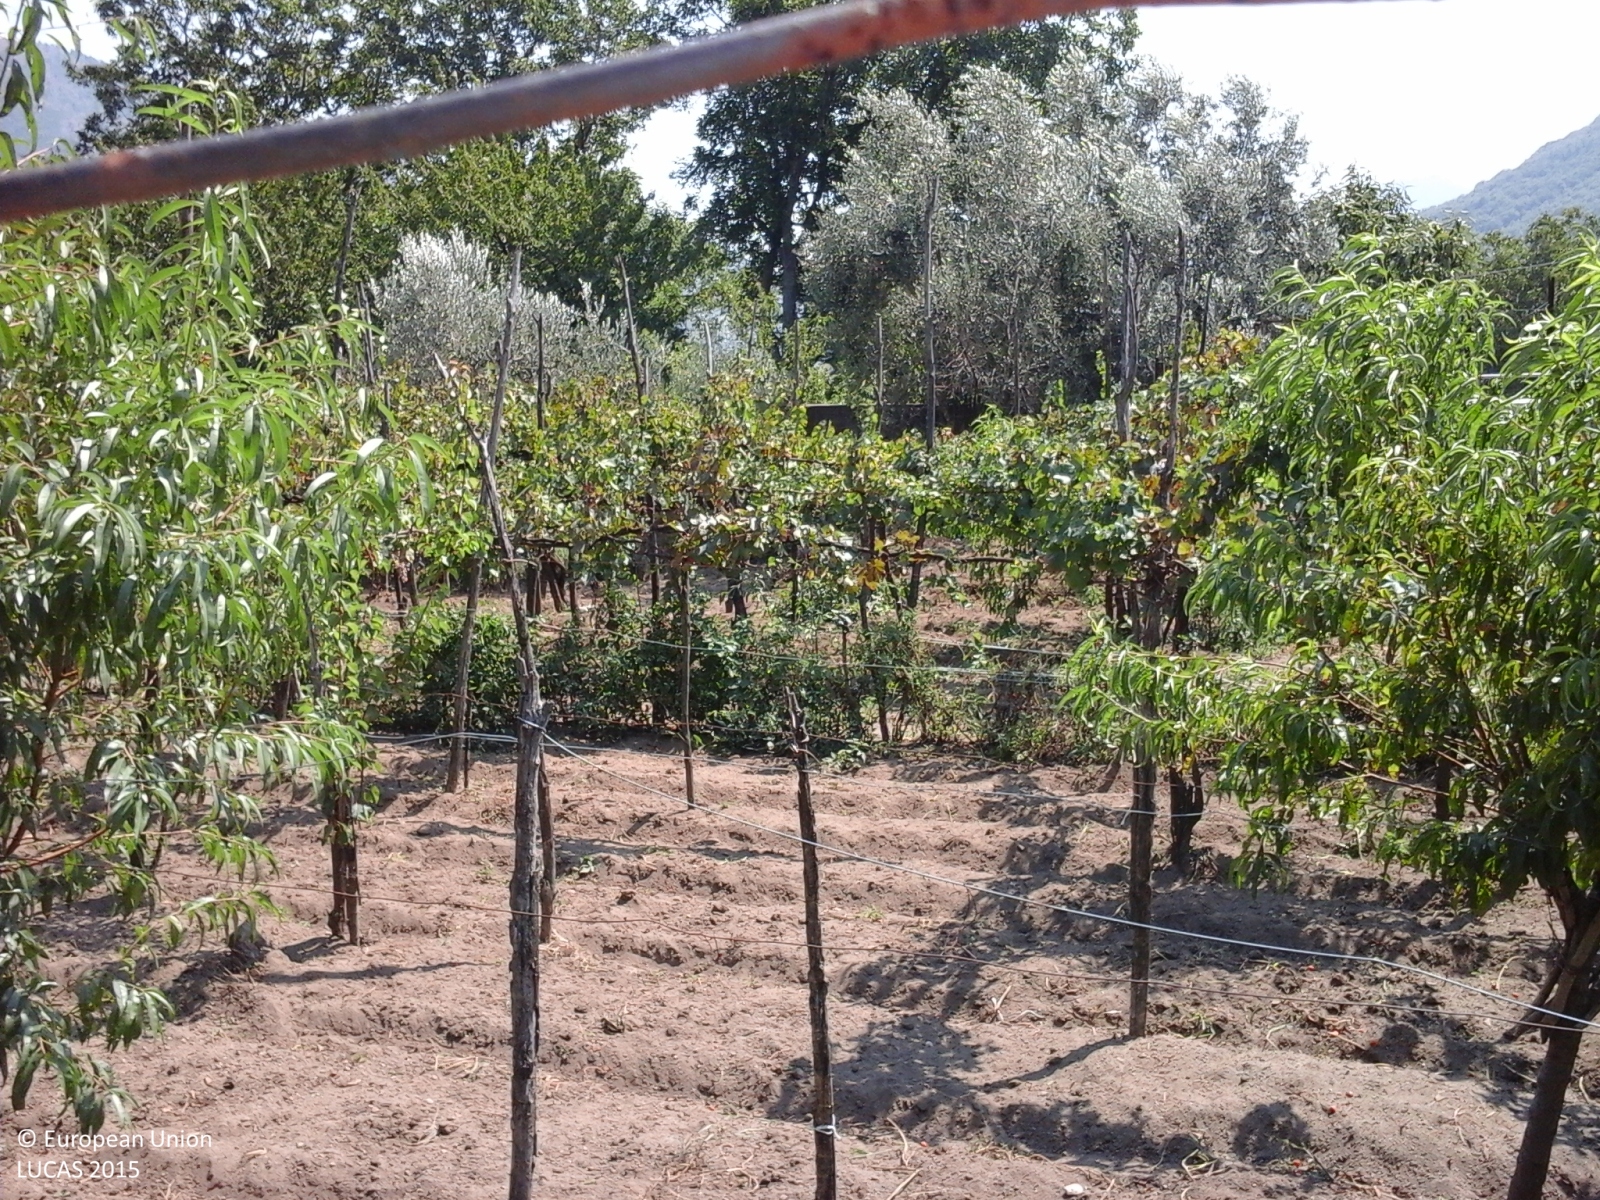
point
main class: Cropland
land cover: Vineyards
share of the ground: 25 - 50 %
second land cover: Tomatoes
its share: < 10 %
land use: Agriculture (excluding fallow land and kitchen gardens)
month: August
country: IT
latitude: 40.8077
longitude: 14.6869
